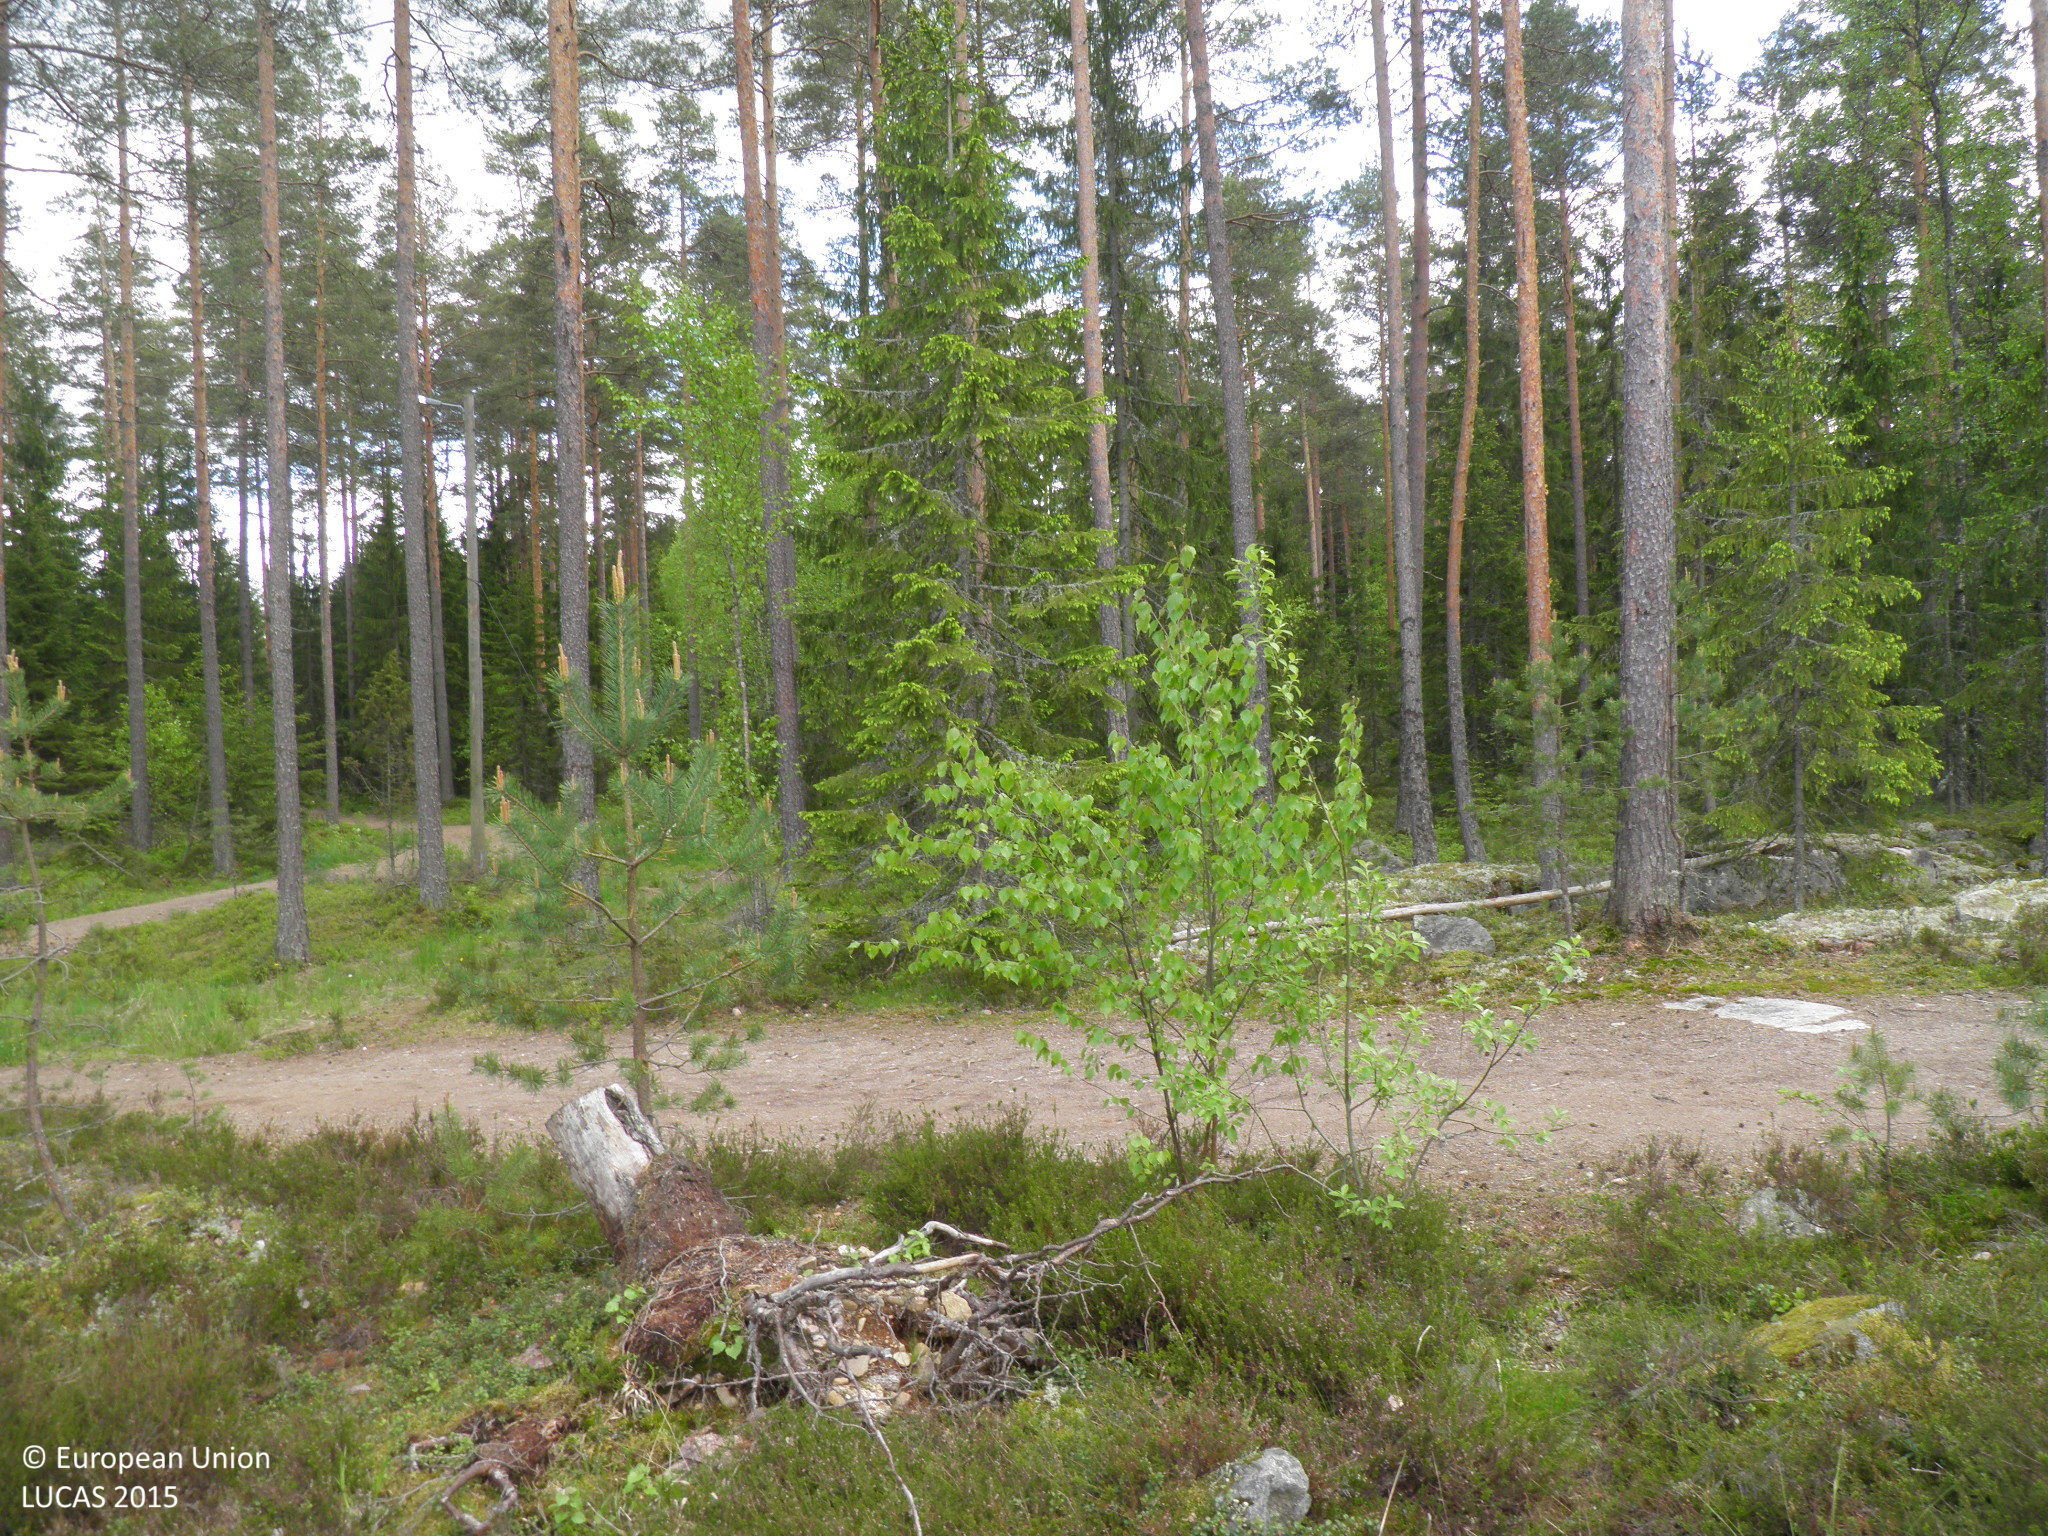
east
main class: Woodland
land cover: Pine dominated coniferous woodland
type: boreal forest
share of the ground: > 75 %
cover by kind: coniferous forest trees 85 %, shrubs 10 %, broadleaved forest trees 5 %
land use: Forestry
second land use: Sport
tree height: > 5 m
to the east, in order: Pine dominated coniferous woodland; Tracks; Electric lines; Pine dominated coniferous woodland
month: June
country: FI
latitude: 60.5850
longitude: 22.7597
